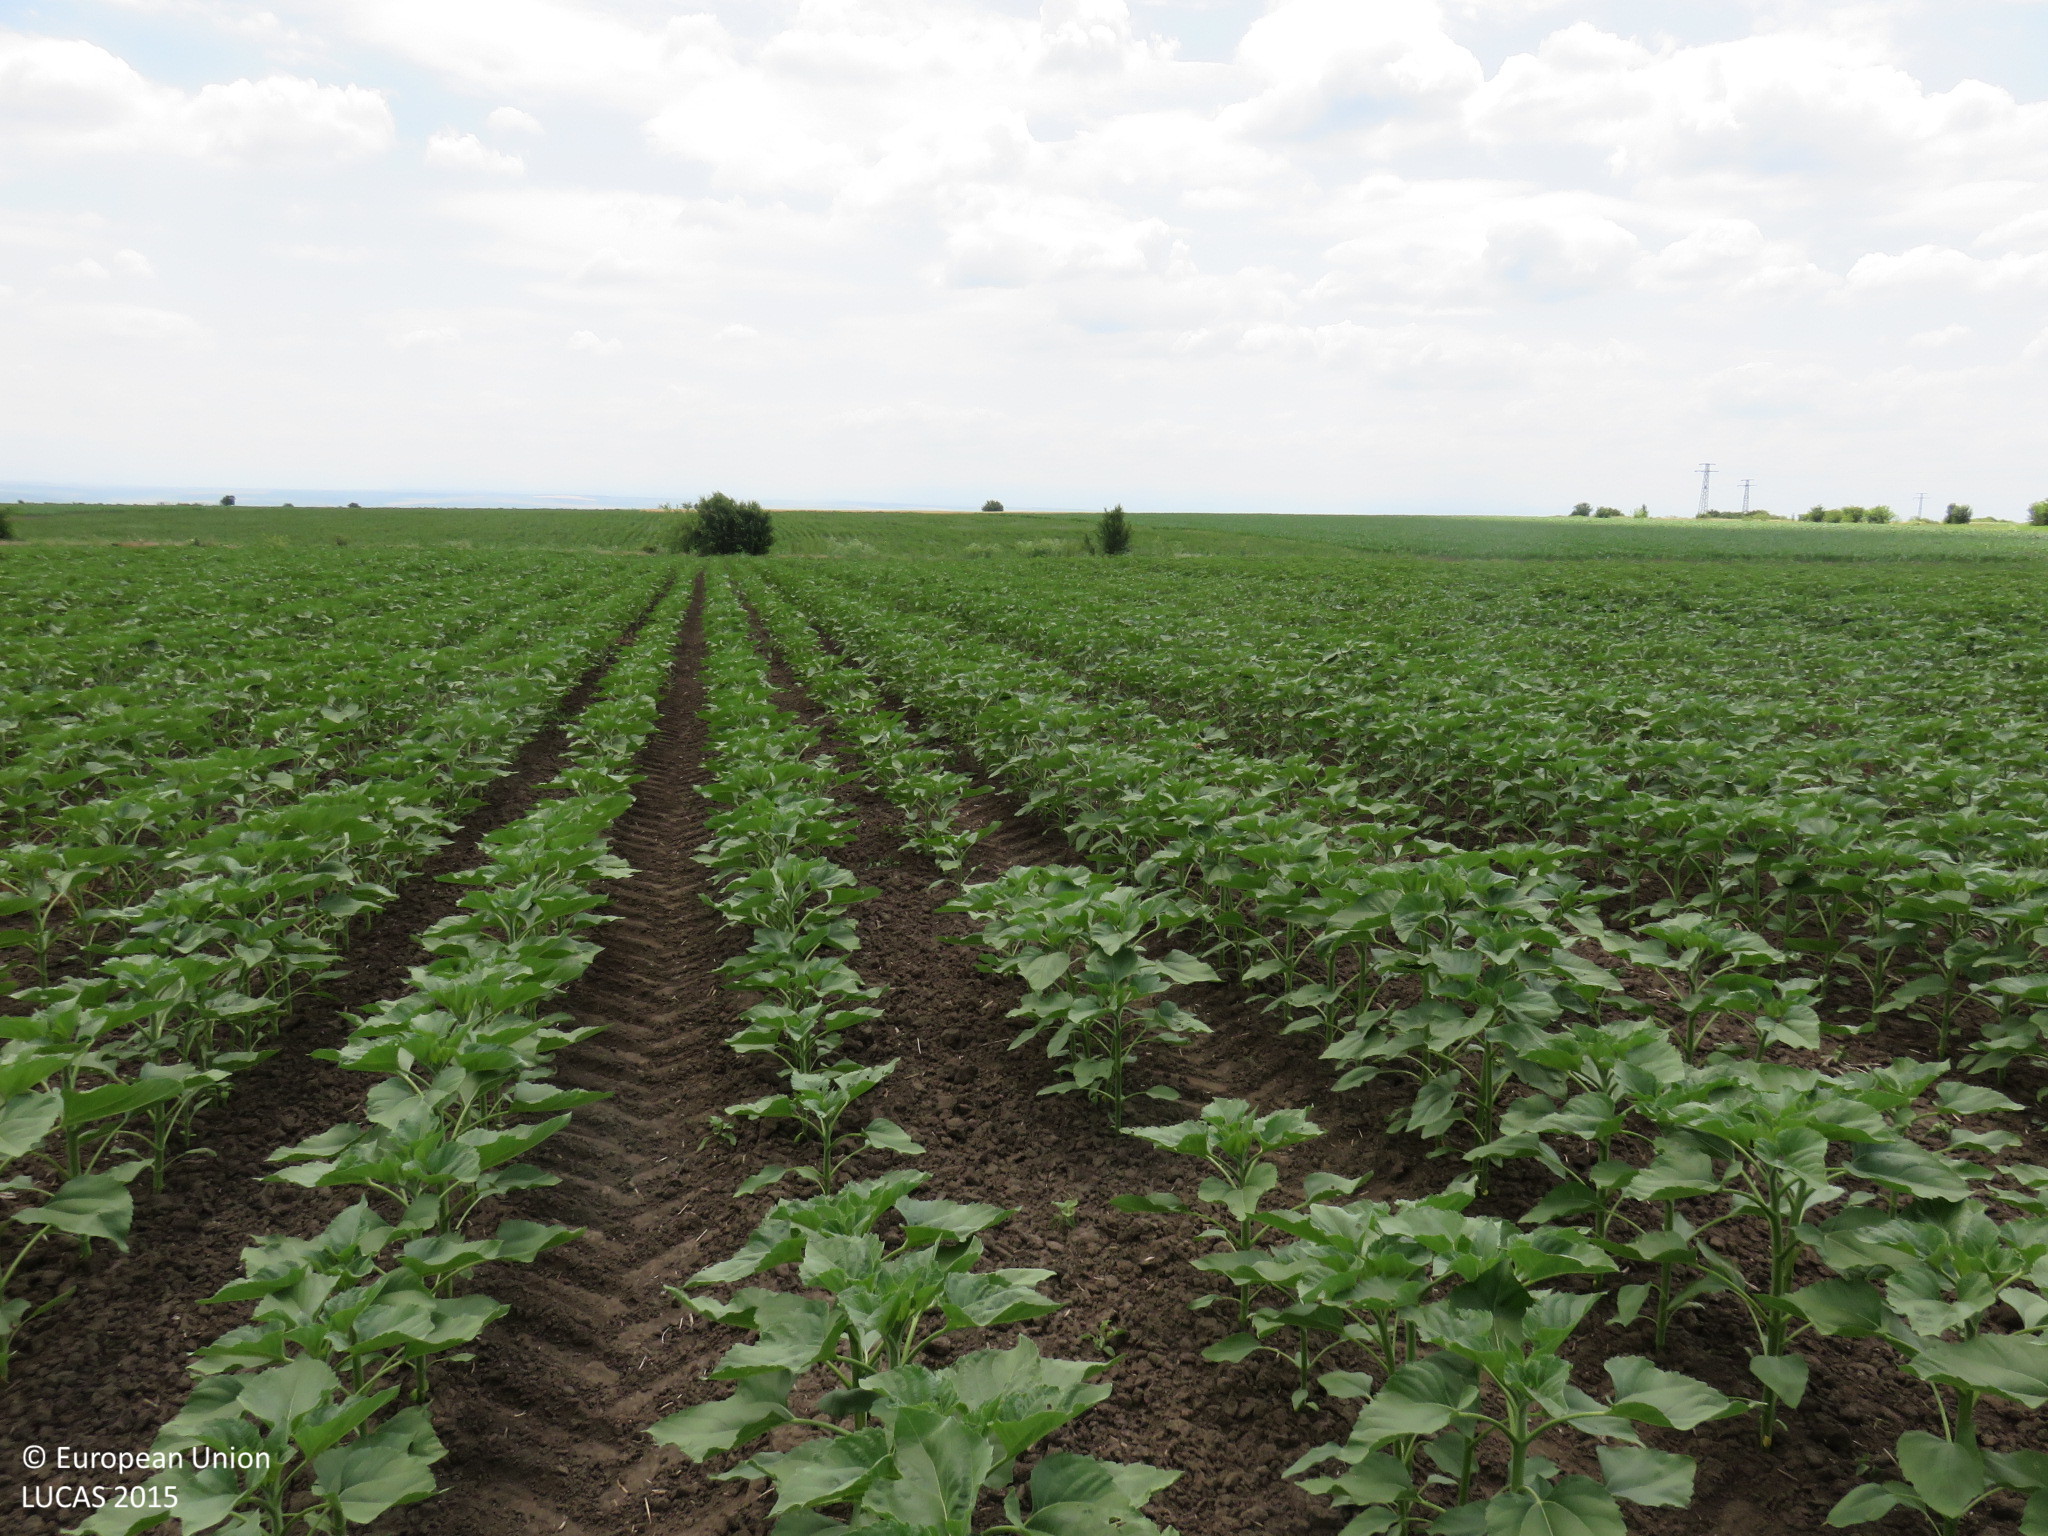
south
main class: Cropland
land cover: Sunflower
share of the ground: > 75 %
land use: Agriculture (excluding fallow land and kitchen gardens)
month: June
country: BG
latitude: 43.5020
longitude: 24.4193
